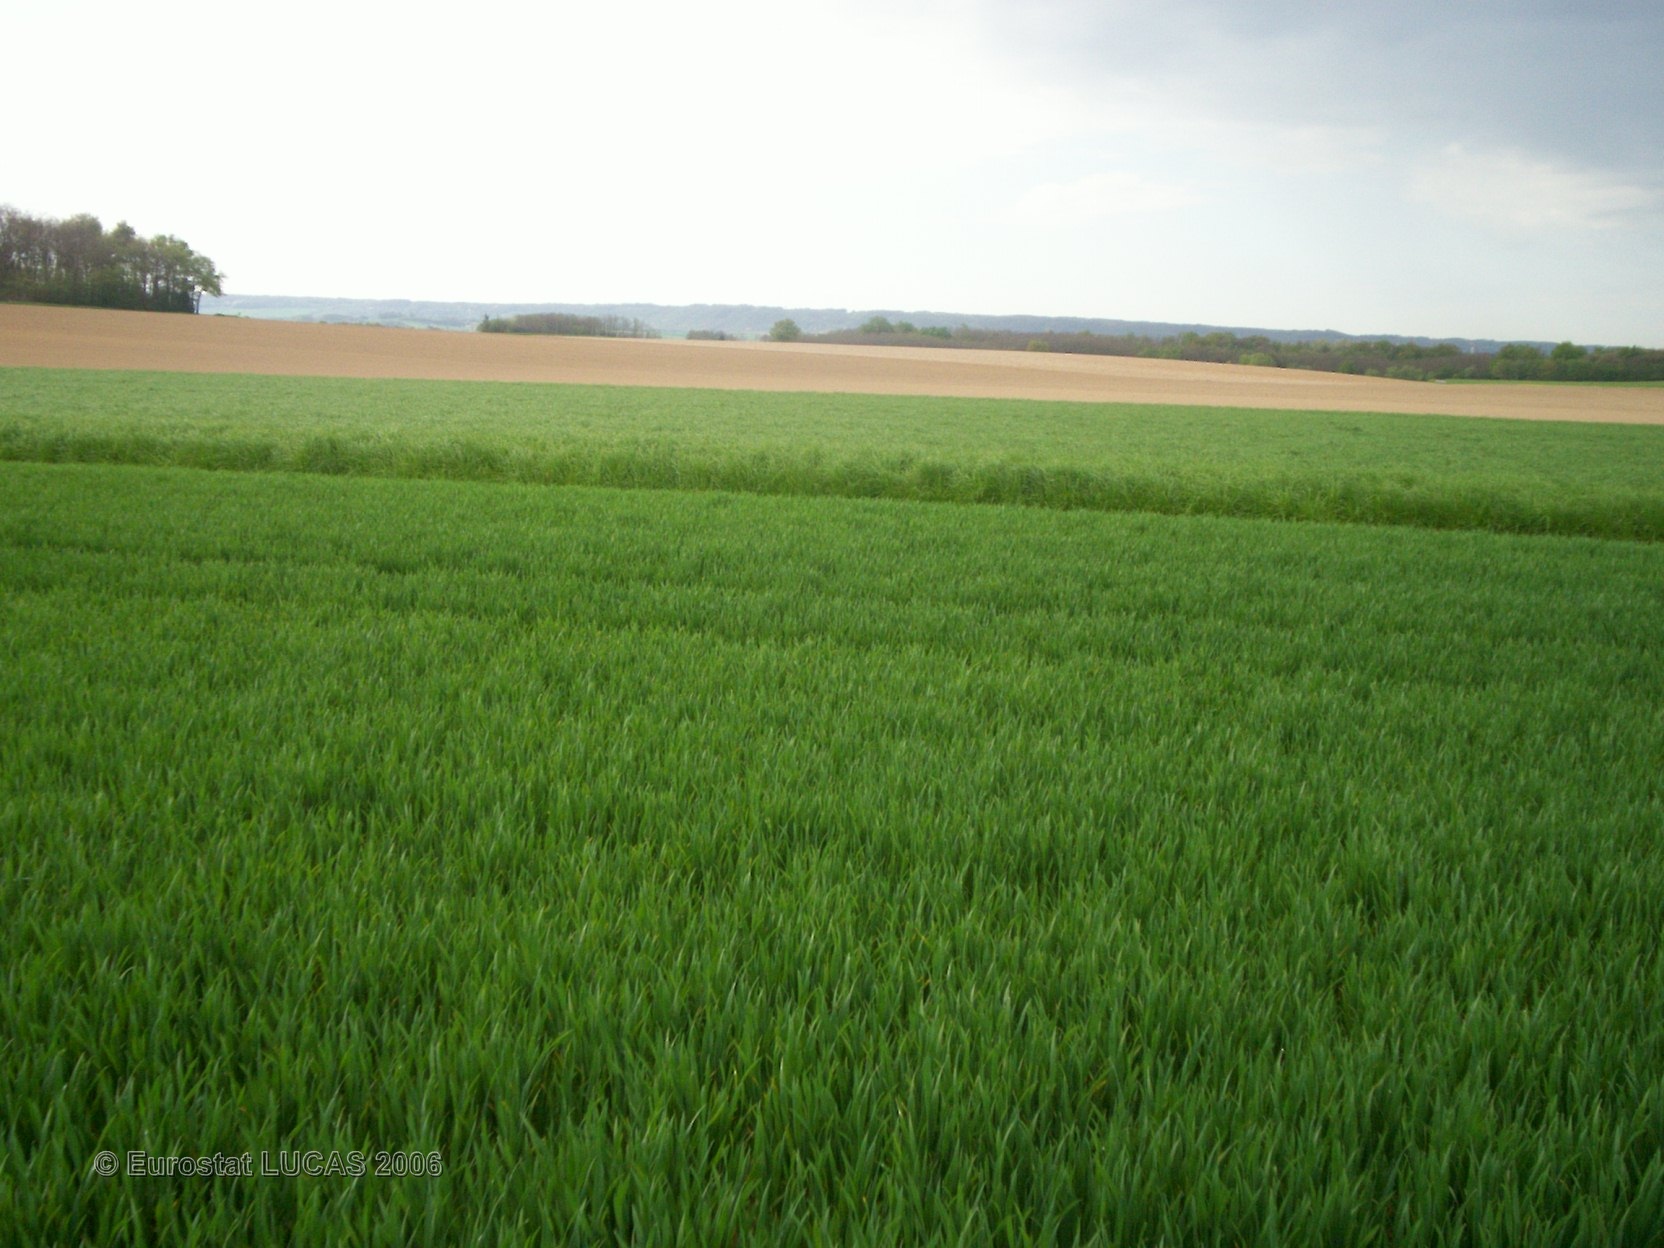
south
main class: Cropland
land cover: Common wheat
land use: Agriculture (excluding fallow land and kitchen gardens)
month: April
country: FR
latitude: 45.3565
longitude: 5.1412
